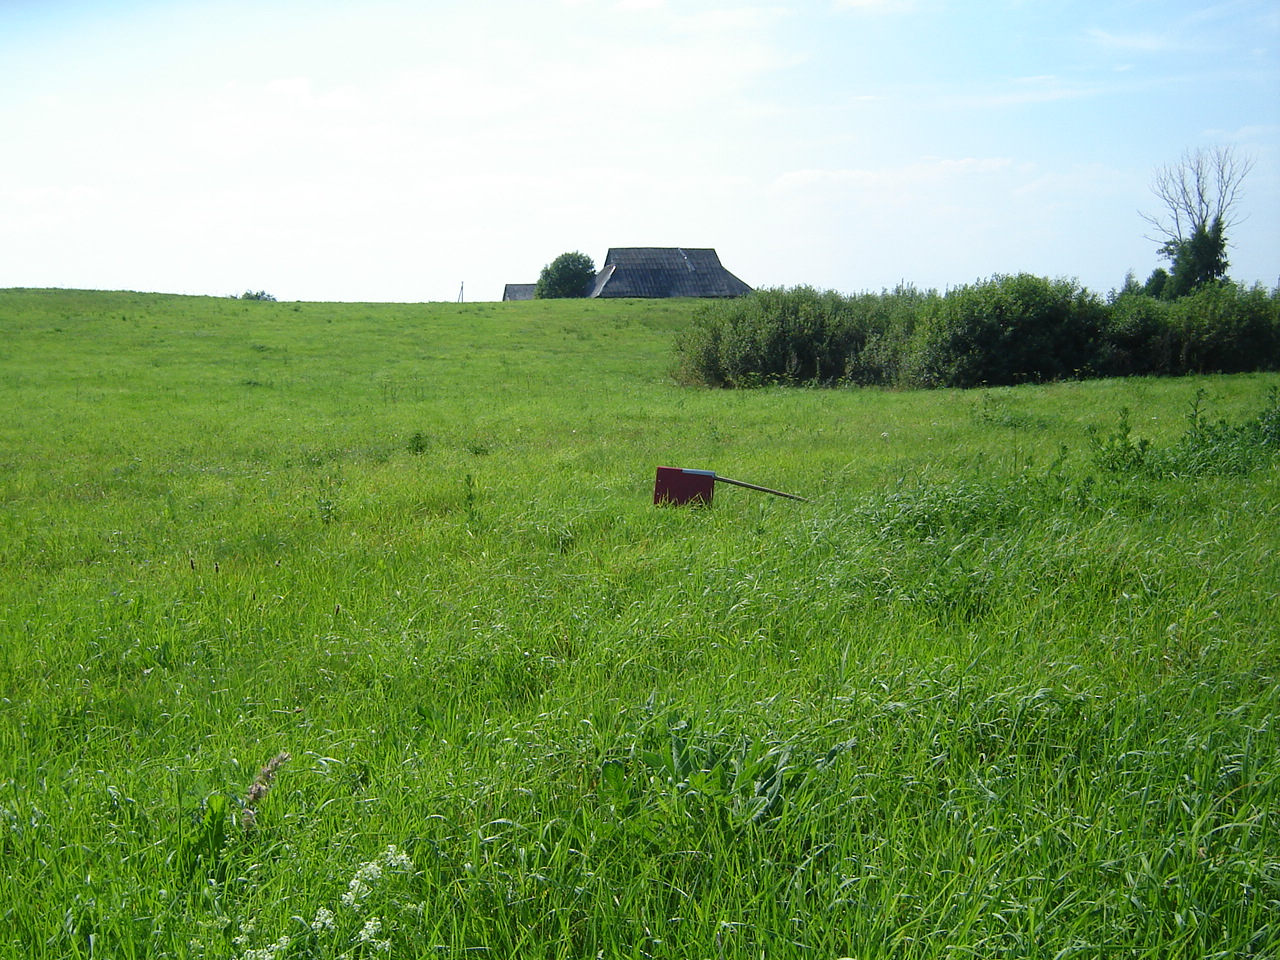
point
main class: Grassland
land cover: Grassland without tree/shrub cover
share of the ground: > 75 %
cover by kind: herbaceous plants 100 %
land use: Agriculture (excluding fallow land and kitchen gardens)
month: August
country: LT
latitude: 55.1553
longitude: 24.9743
